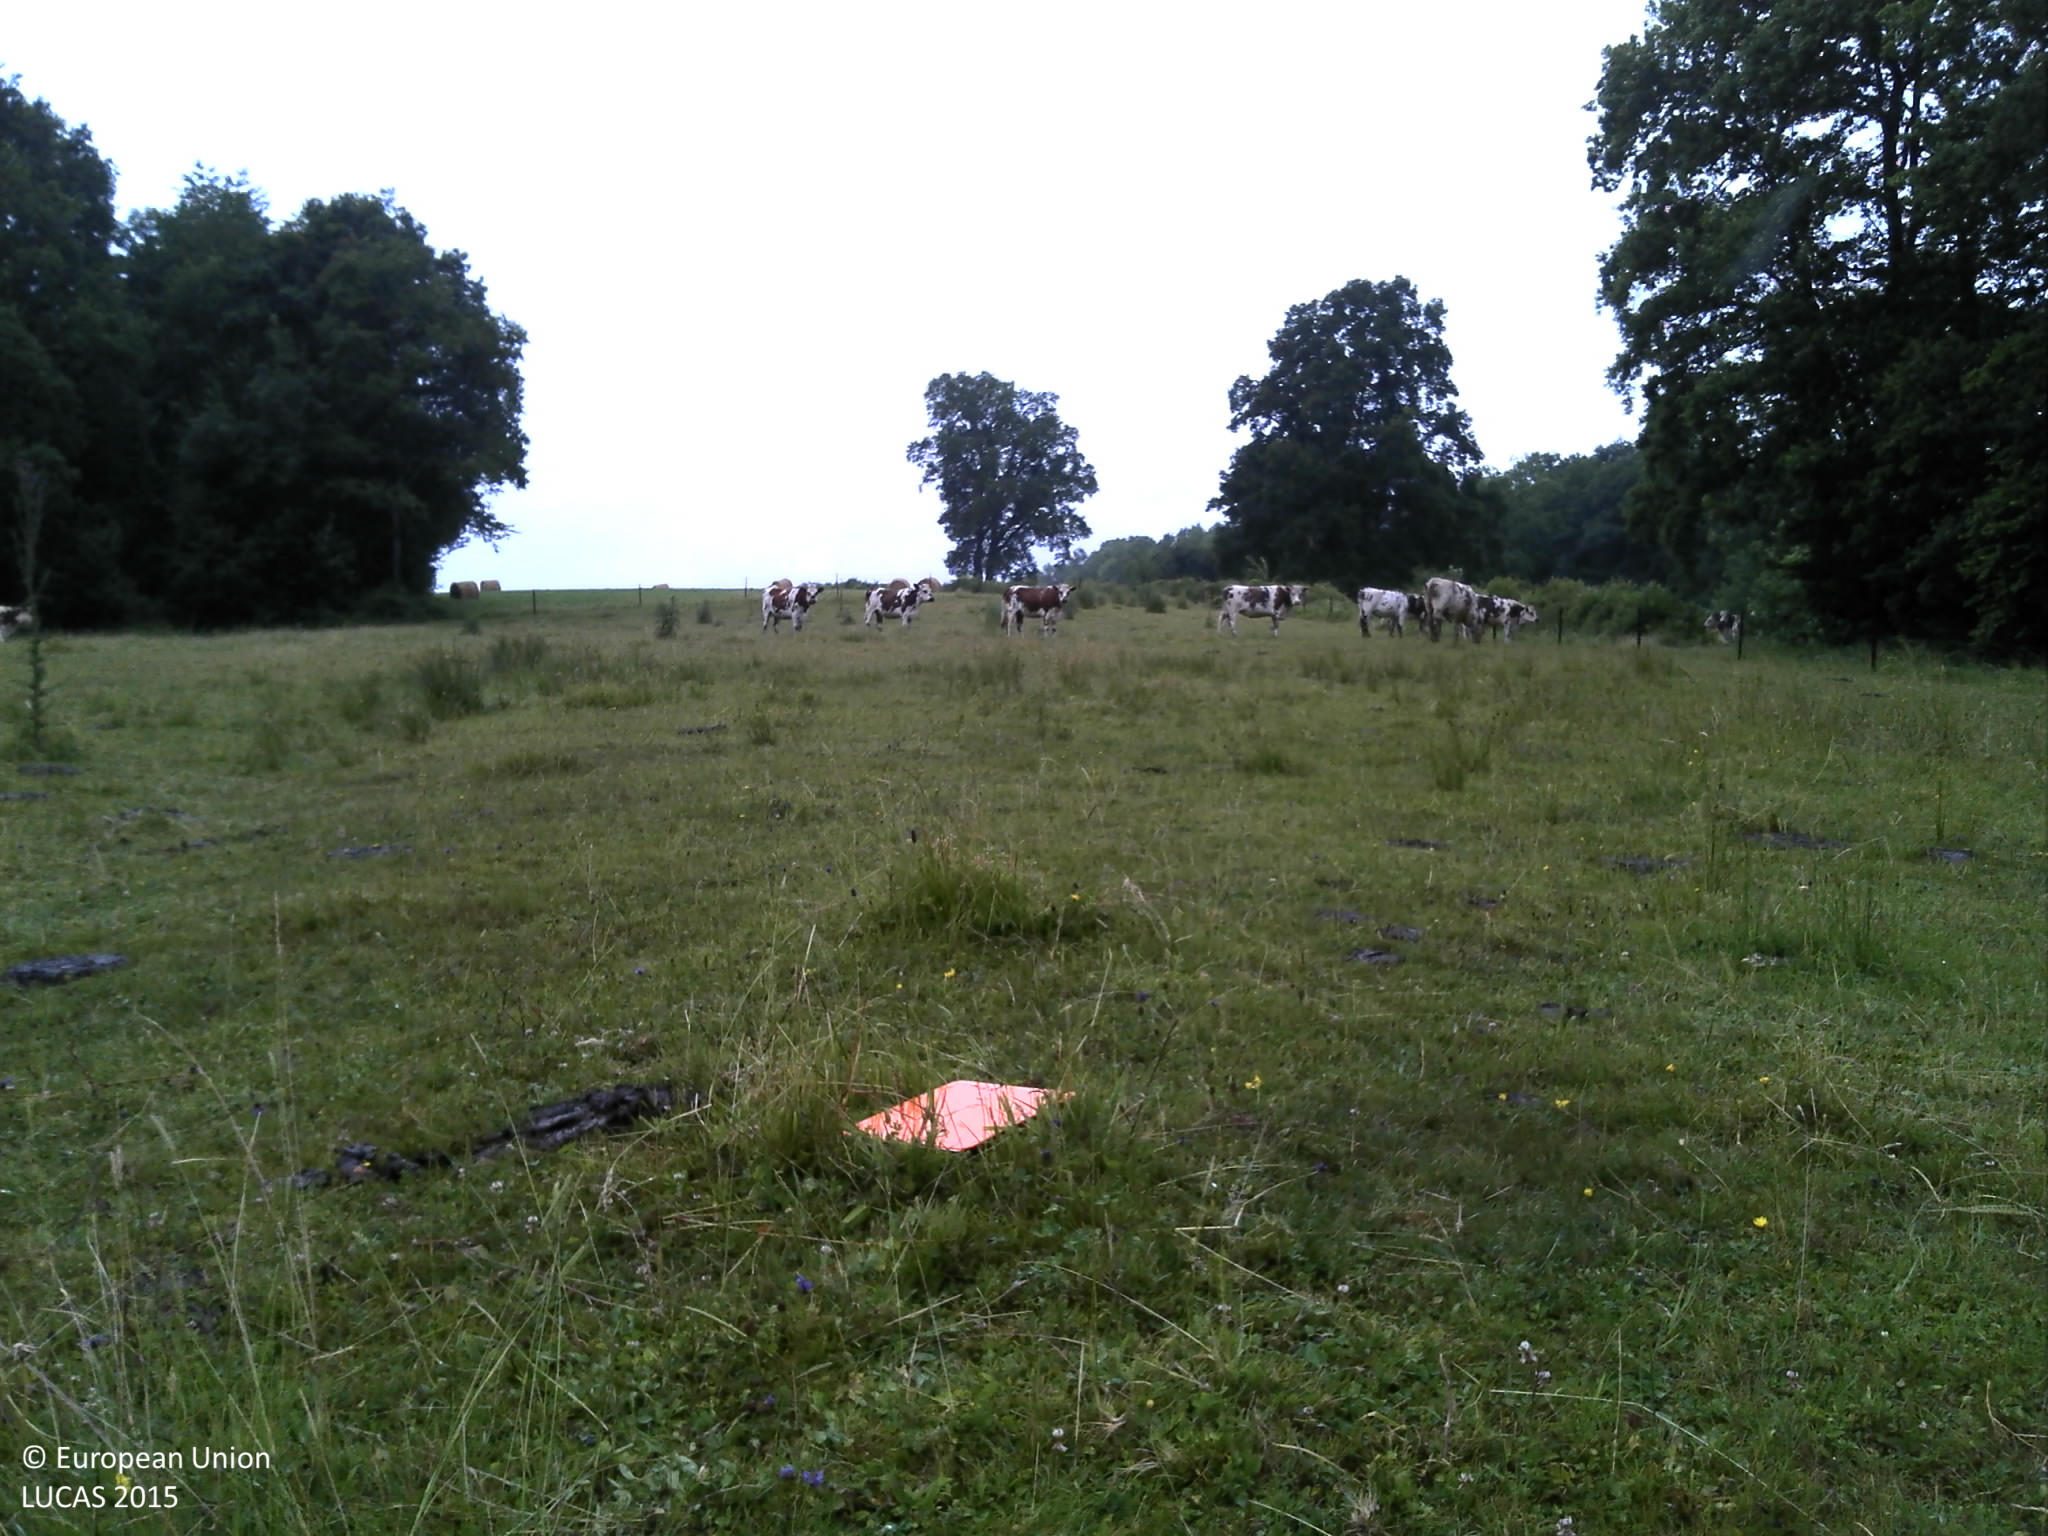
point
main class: Grassland
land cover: Grassland without tree/shrub cover
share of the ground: > 75 %
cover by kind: herbaceous plants 100 %
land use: Agriculture (excluding fallow land and kitchen gardens)
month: June
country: FR
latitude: 49.5603
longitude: 4.7849
